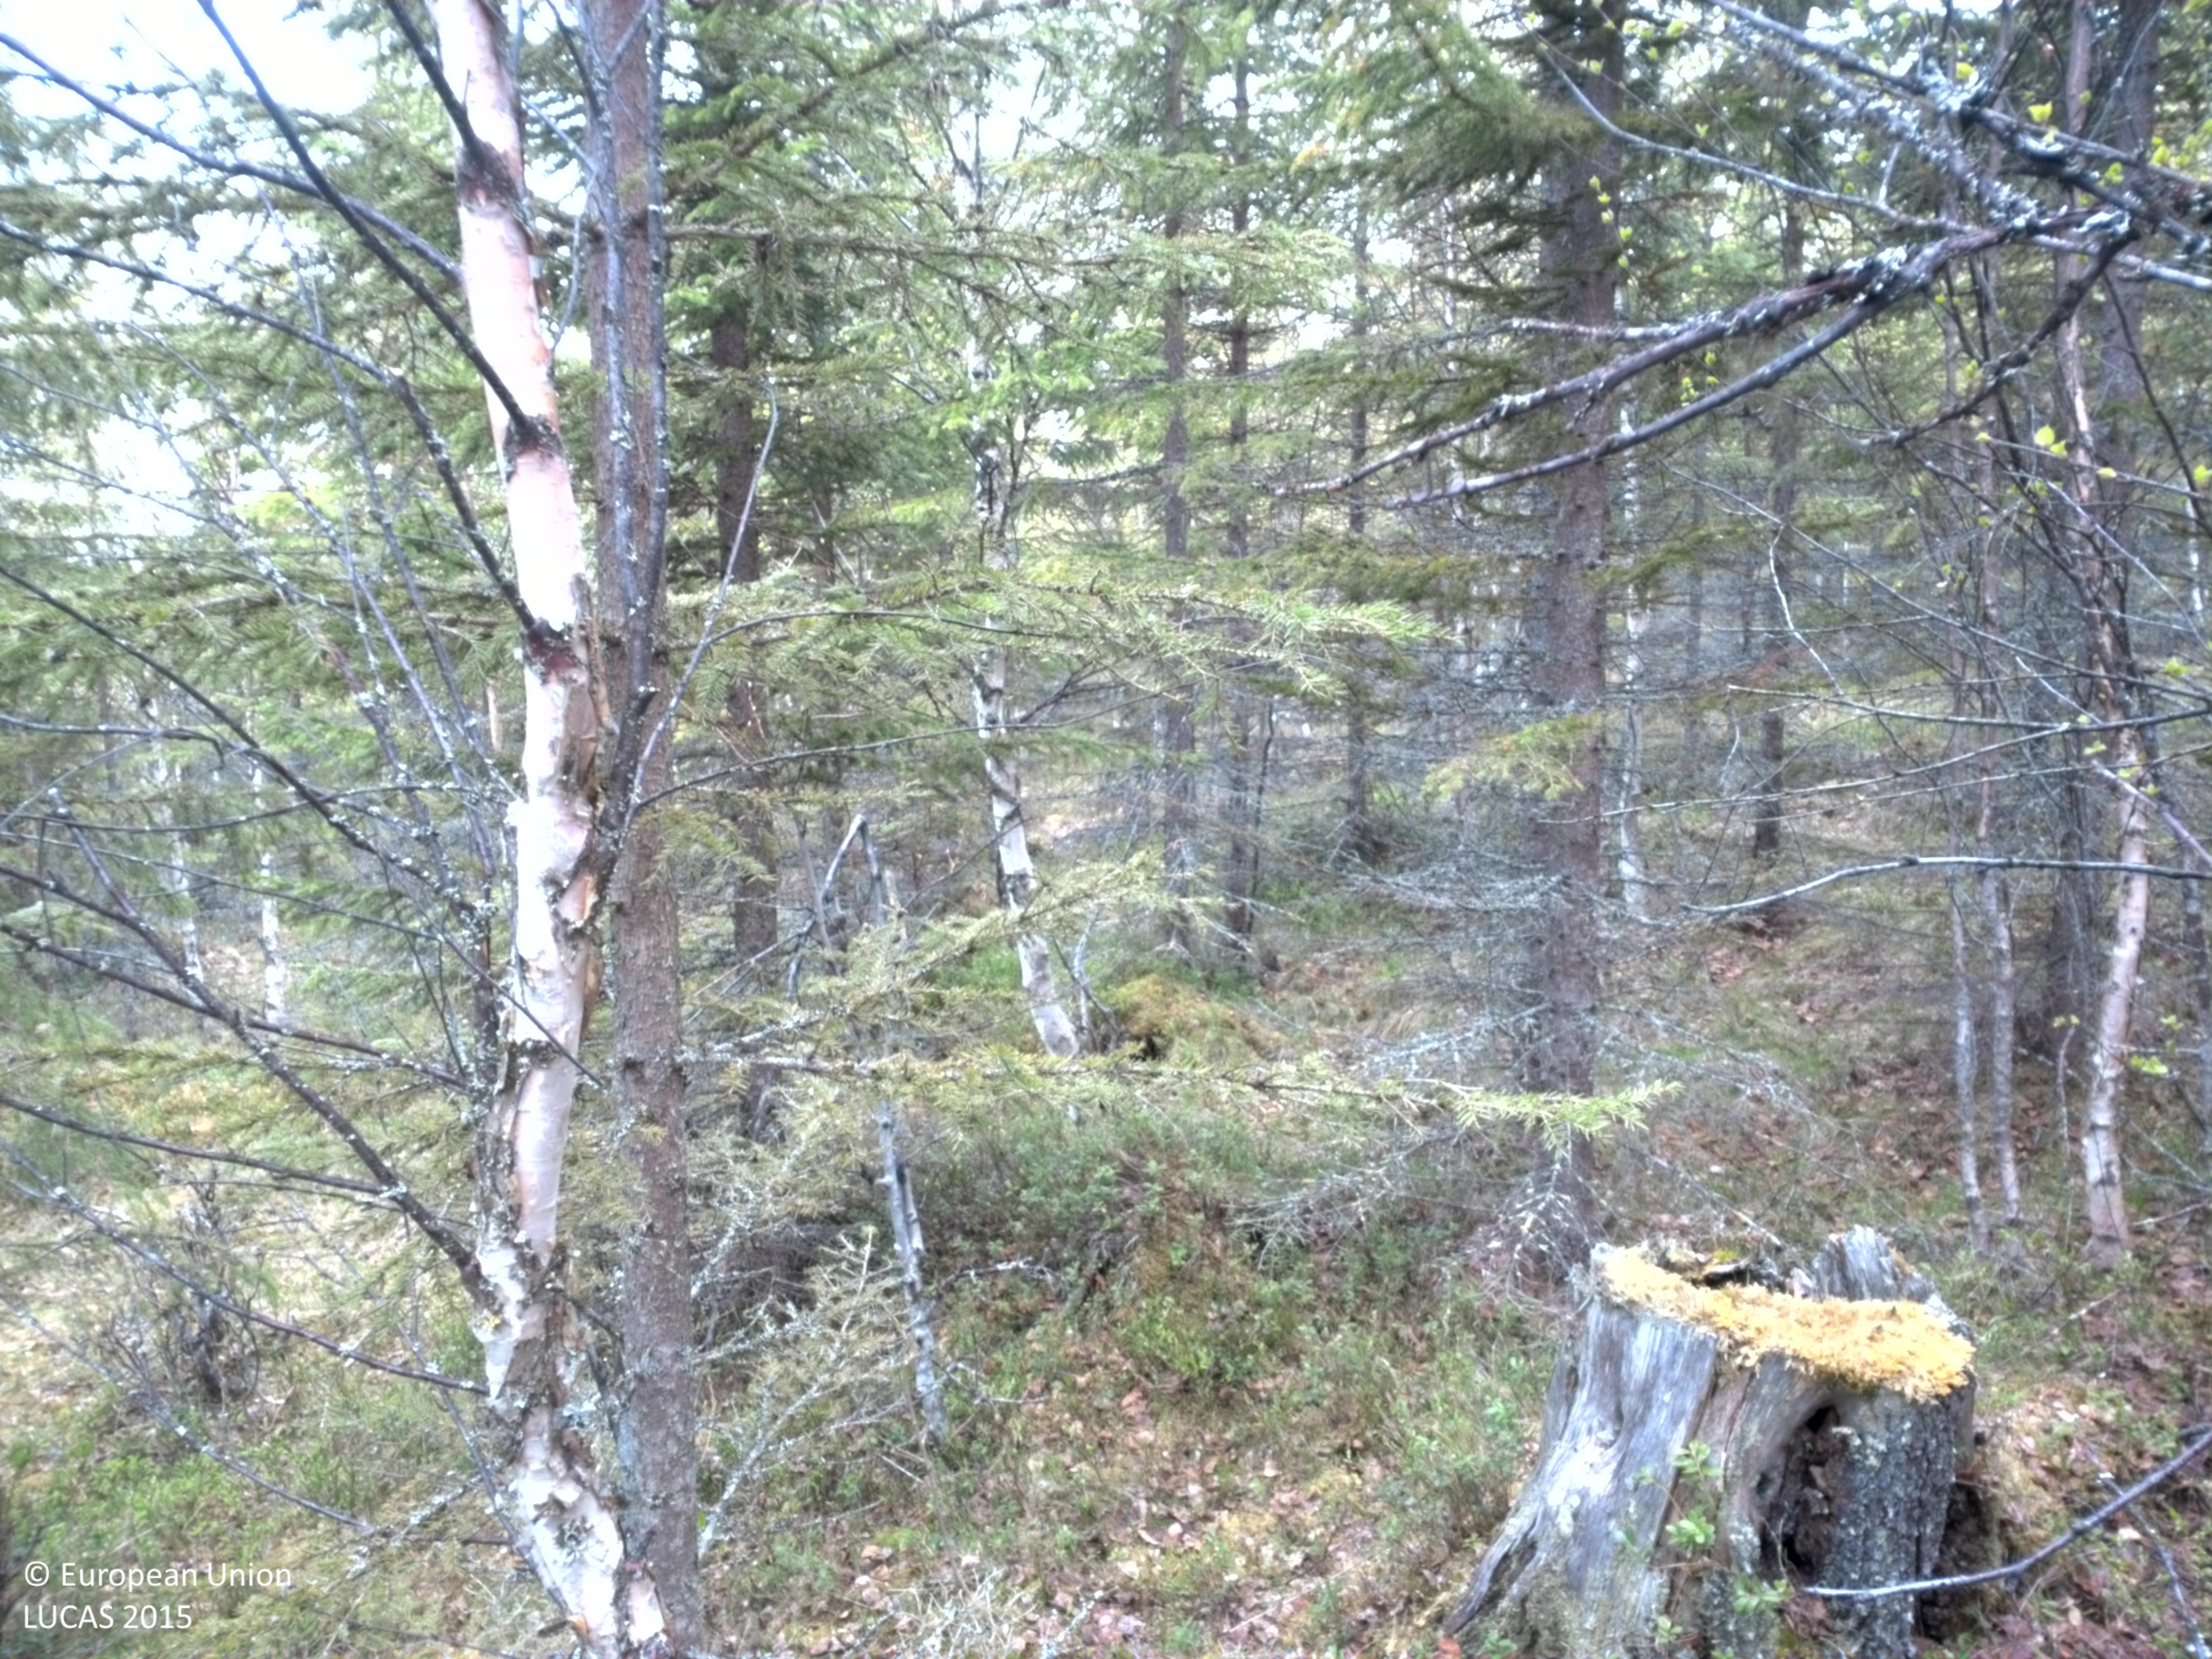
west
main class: Woodland
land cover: Spruce dominated mixed woodland
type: boreal forest
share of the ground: 50 - 75 %
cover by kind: coniferous forest trees 35 %, broadleaved forest trees 35 %, herbaceous plants 20 %, shrubs 5 %, lichens and mosses 5 %
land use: Forestry
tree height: > 5 m
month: June
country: SE
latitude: 64.3680
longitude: 18.1941
